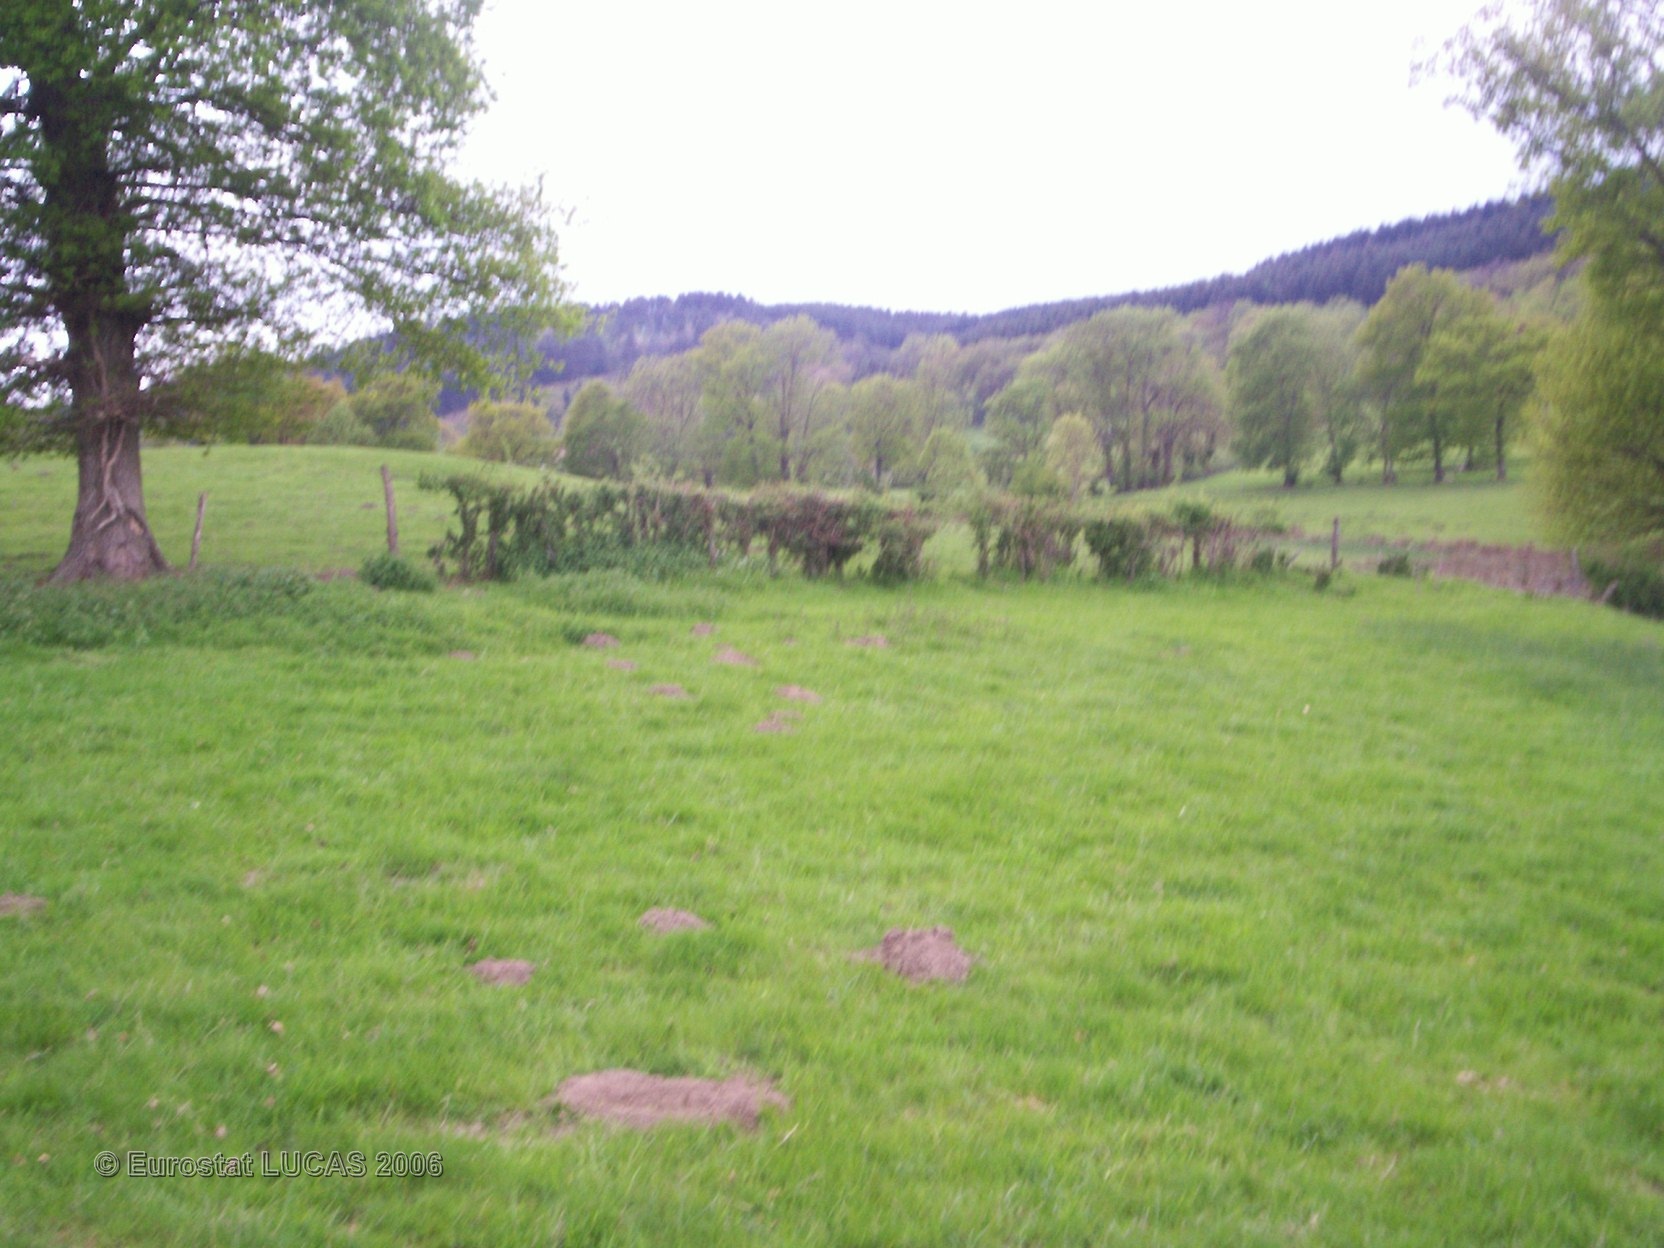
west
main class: Grassland
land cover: Grassland without tree/shrub cover
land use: Agriculture (excluding fallow land and kitchen gardens)
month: May
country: FR
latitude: 46.4722
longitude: 3.1081
